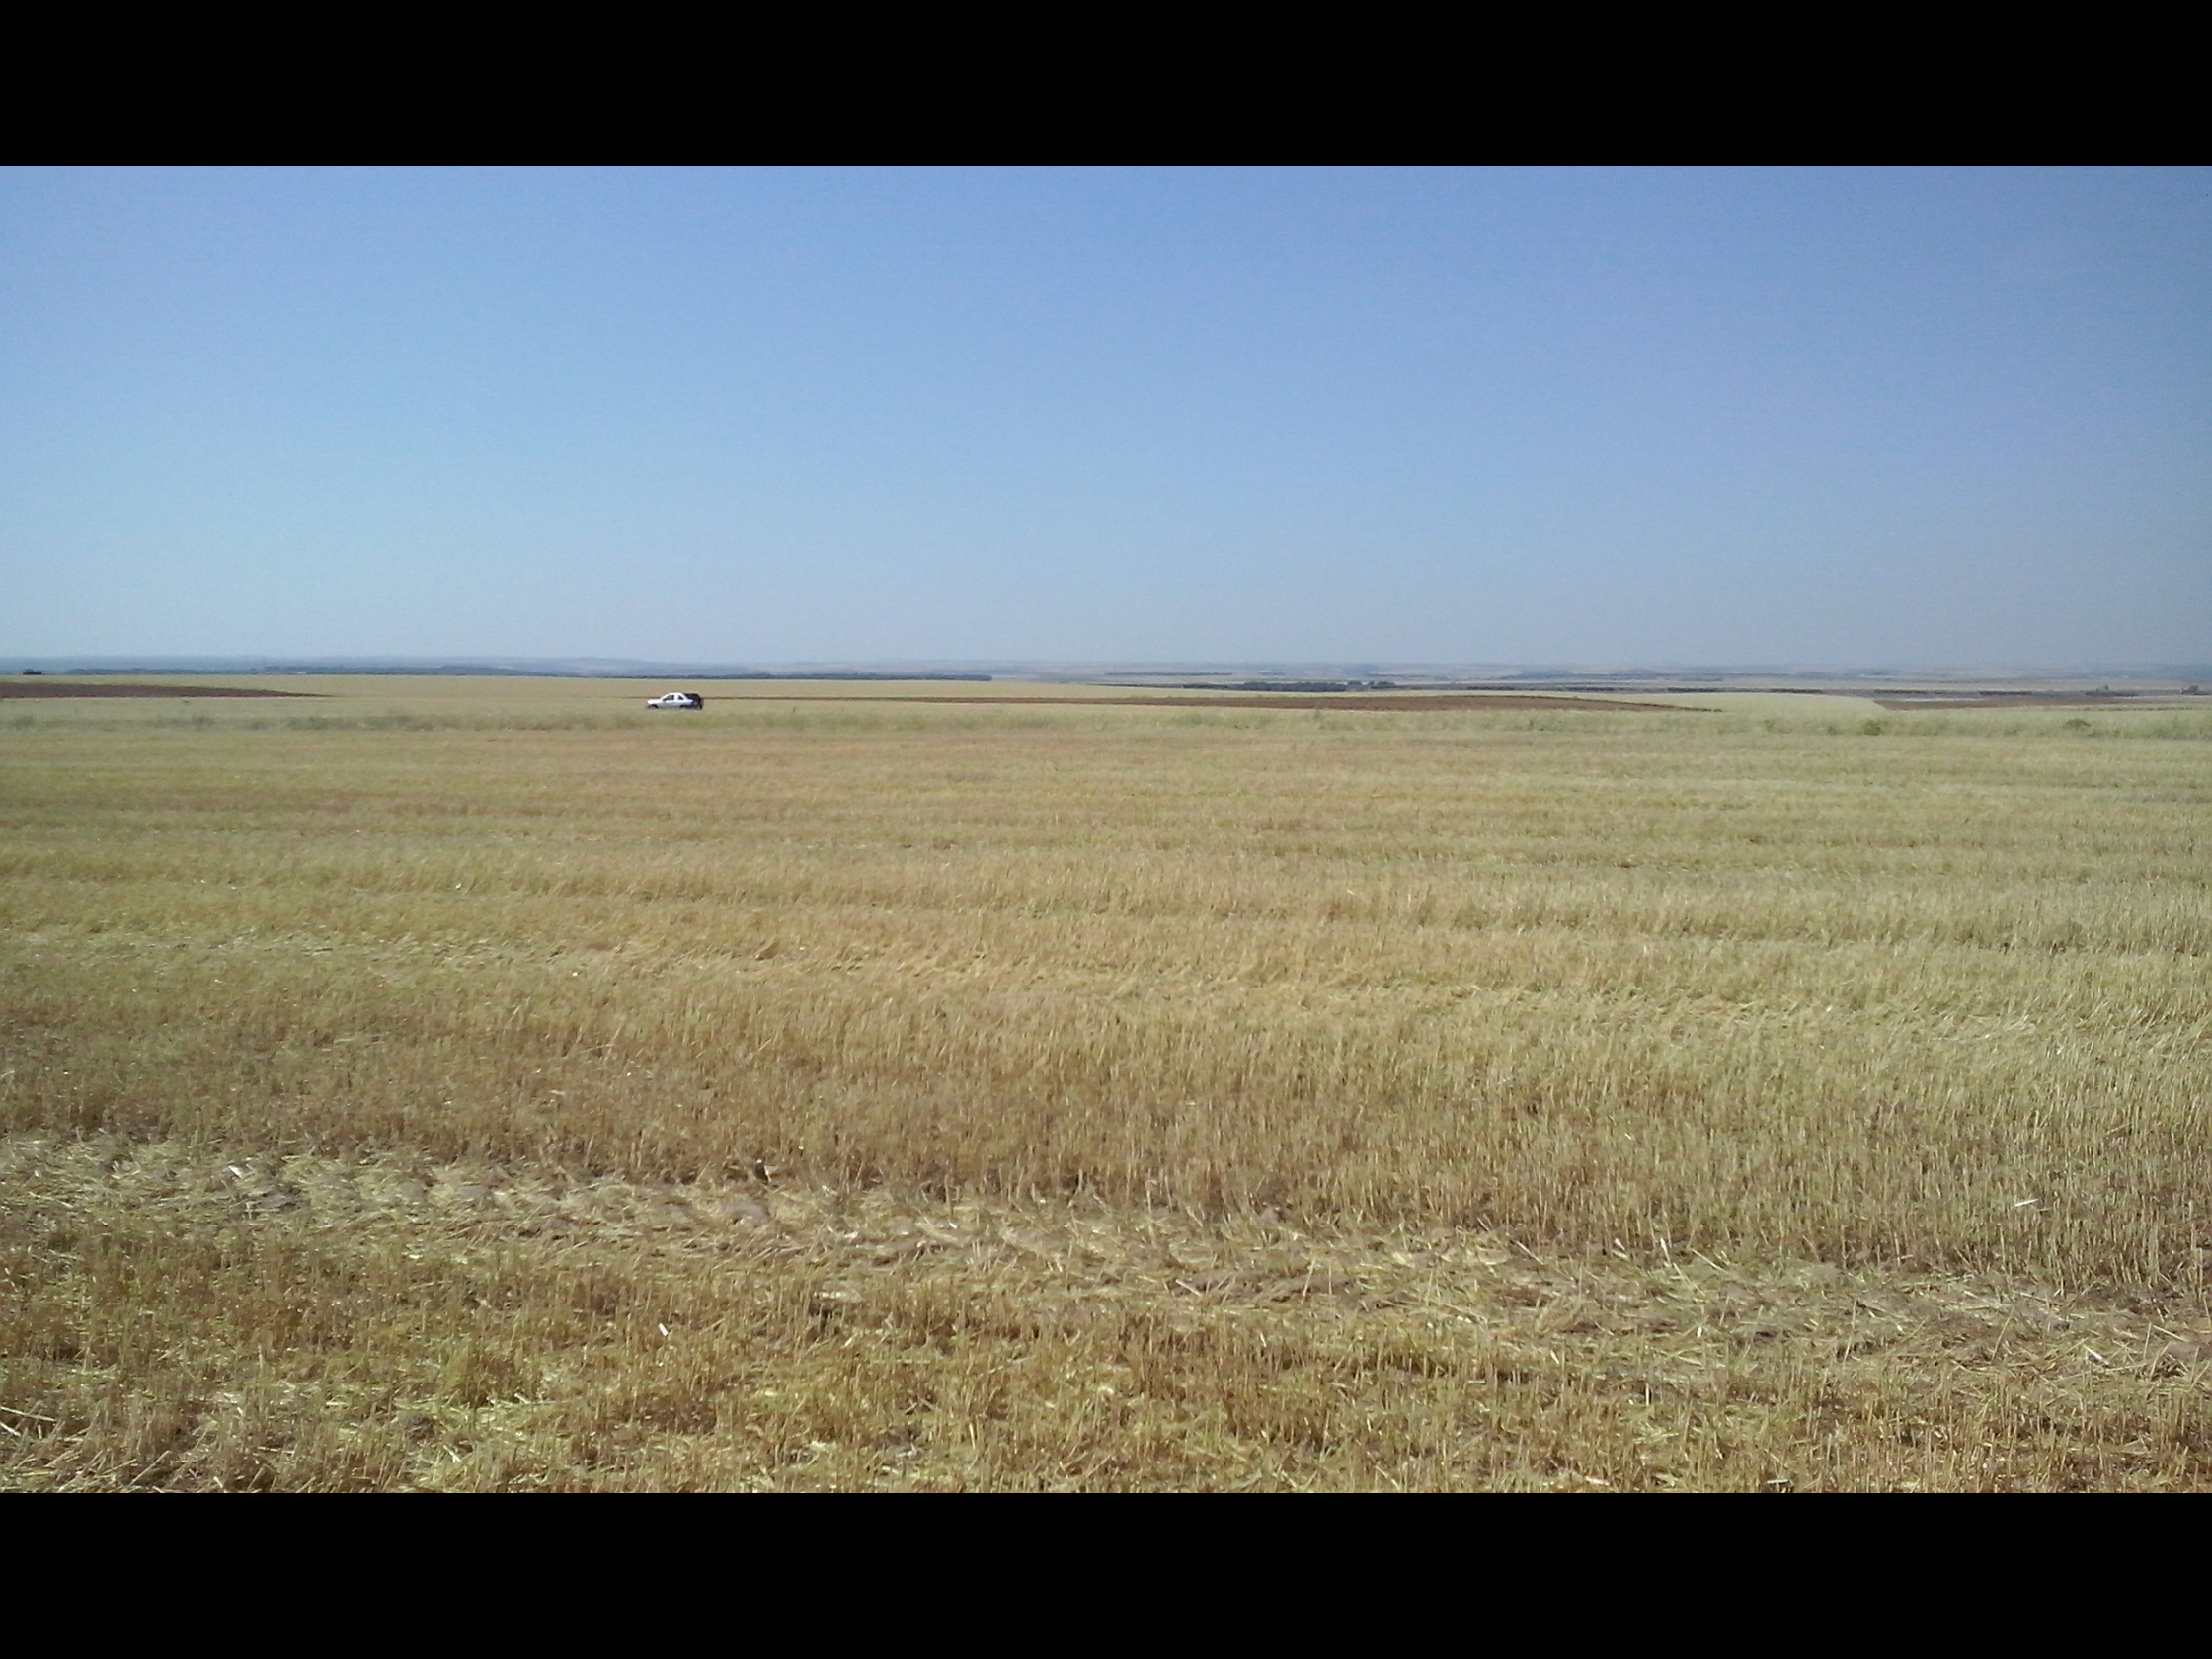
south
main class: Cropland
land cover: Barley
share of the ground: < 10 %
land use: Agriculture (excluding fallow land and kitchen gardens)
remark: Harvested field
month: July
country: ES
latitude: 41.5304
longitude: -5.1158
